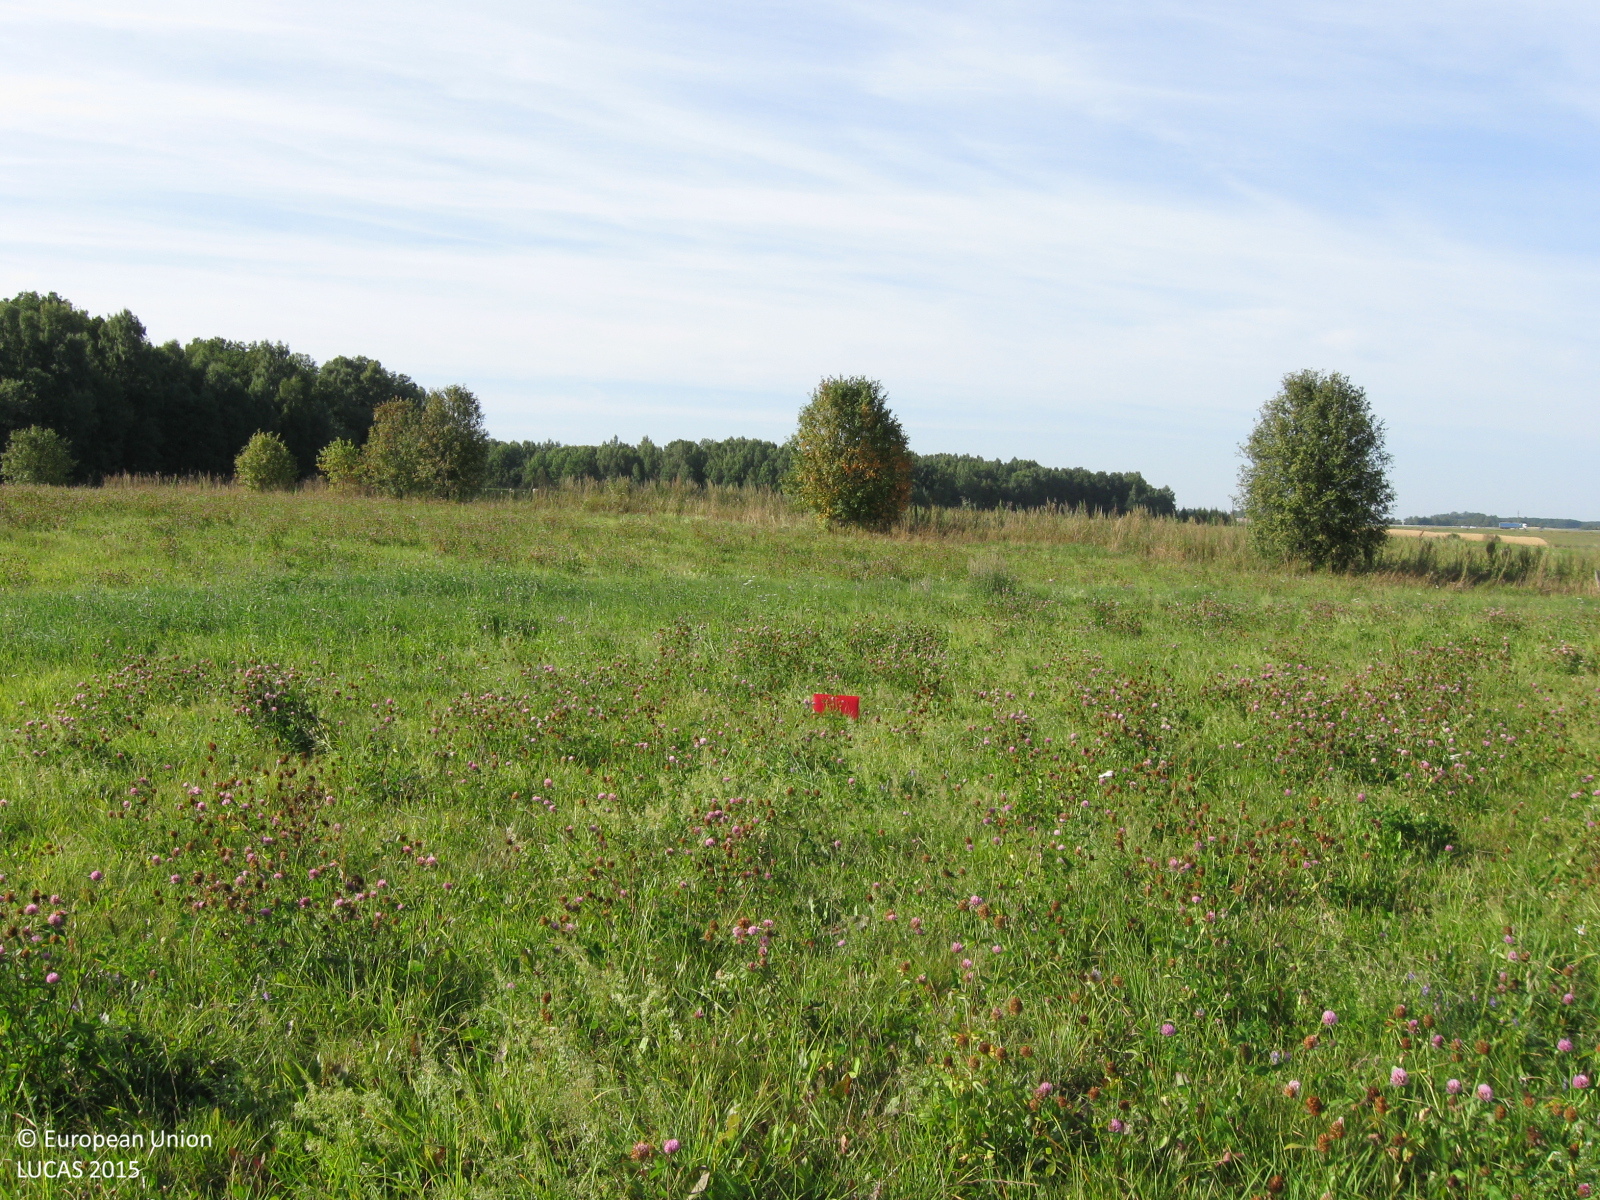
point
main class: Grassland
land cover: Grassland without tree/shrub cover
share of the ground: > 75 %
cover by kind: herbaceous plants 100 %
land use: Agriculture (excluding fallow land and kitchen gardens)
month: August
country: LT
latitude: 55.4748
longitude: 22.5765
